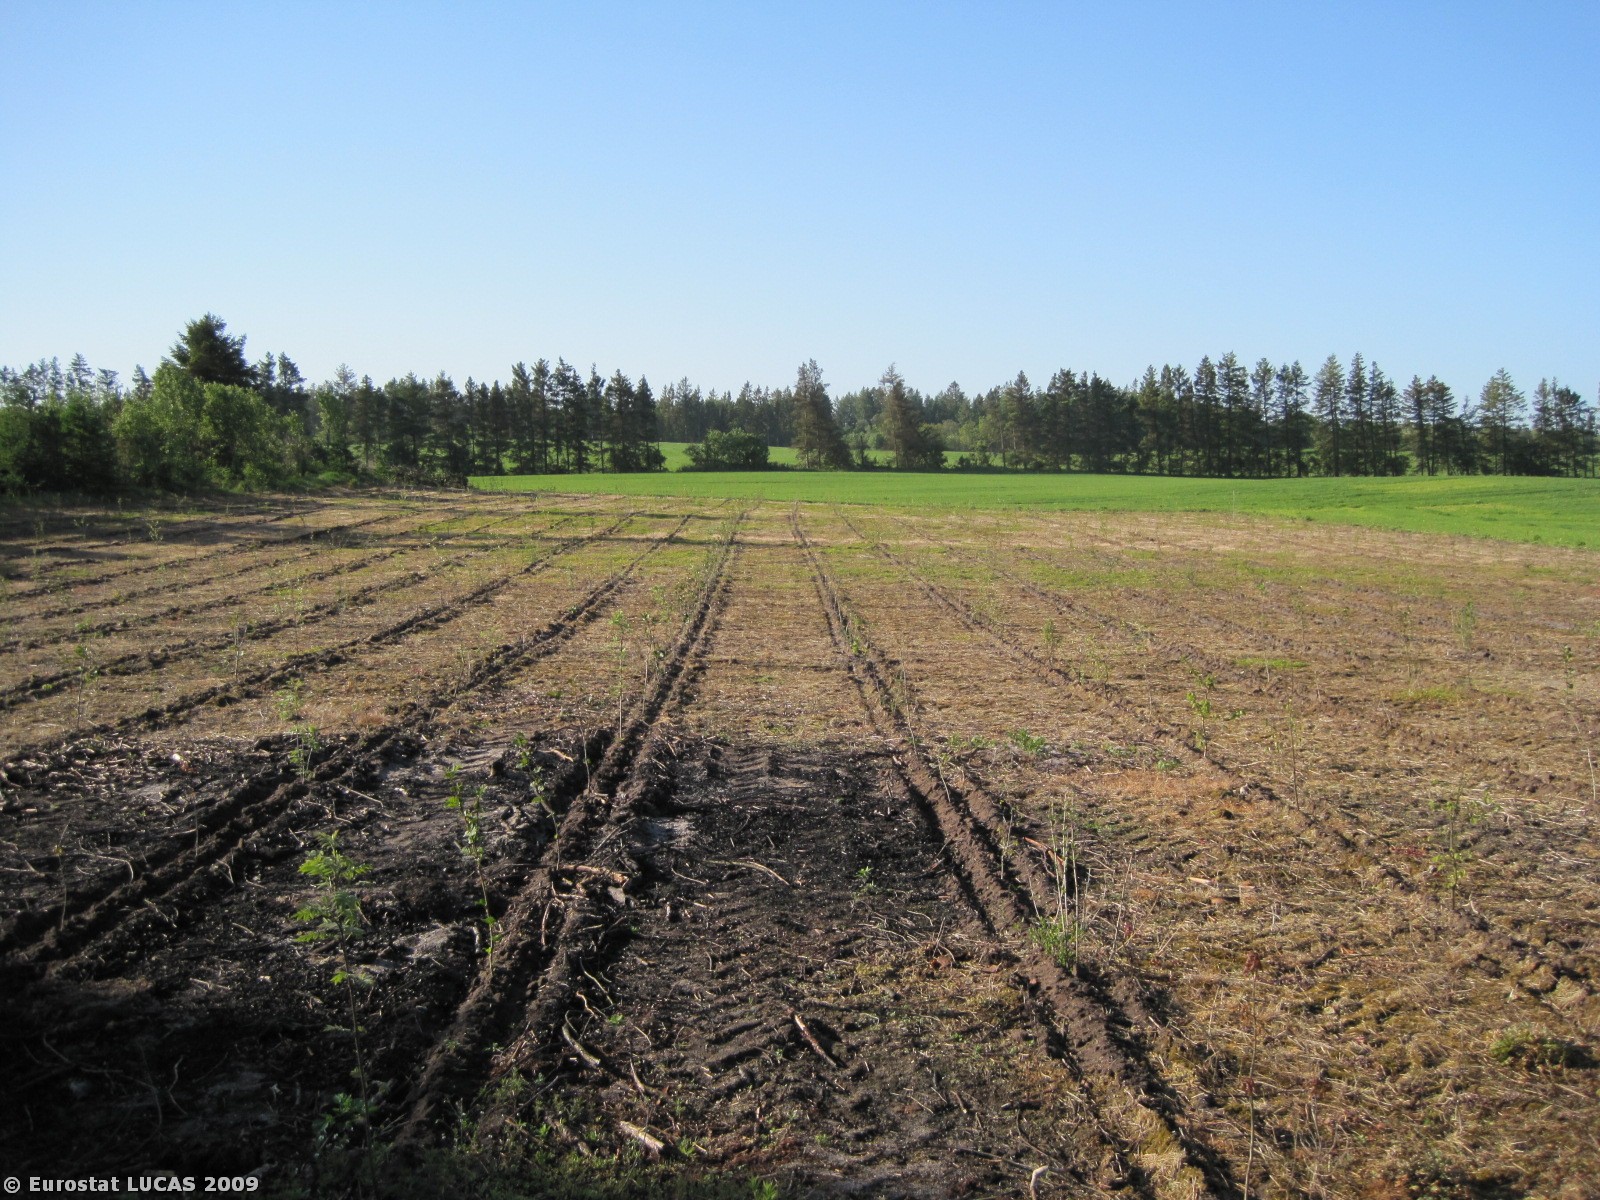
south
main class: Woodland
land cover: Broadleaved woodland
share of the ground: < 10 %
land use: Agriculture (excluding fallow land and kitchen gardens)
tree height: < 5 m
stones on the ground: < 10 %
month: May
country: DK
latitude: 56.4012
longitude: 9.2394
